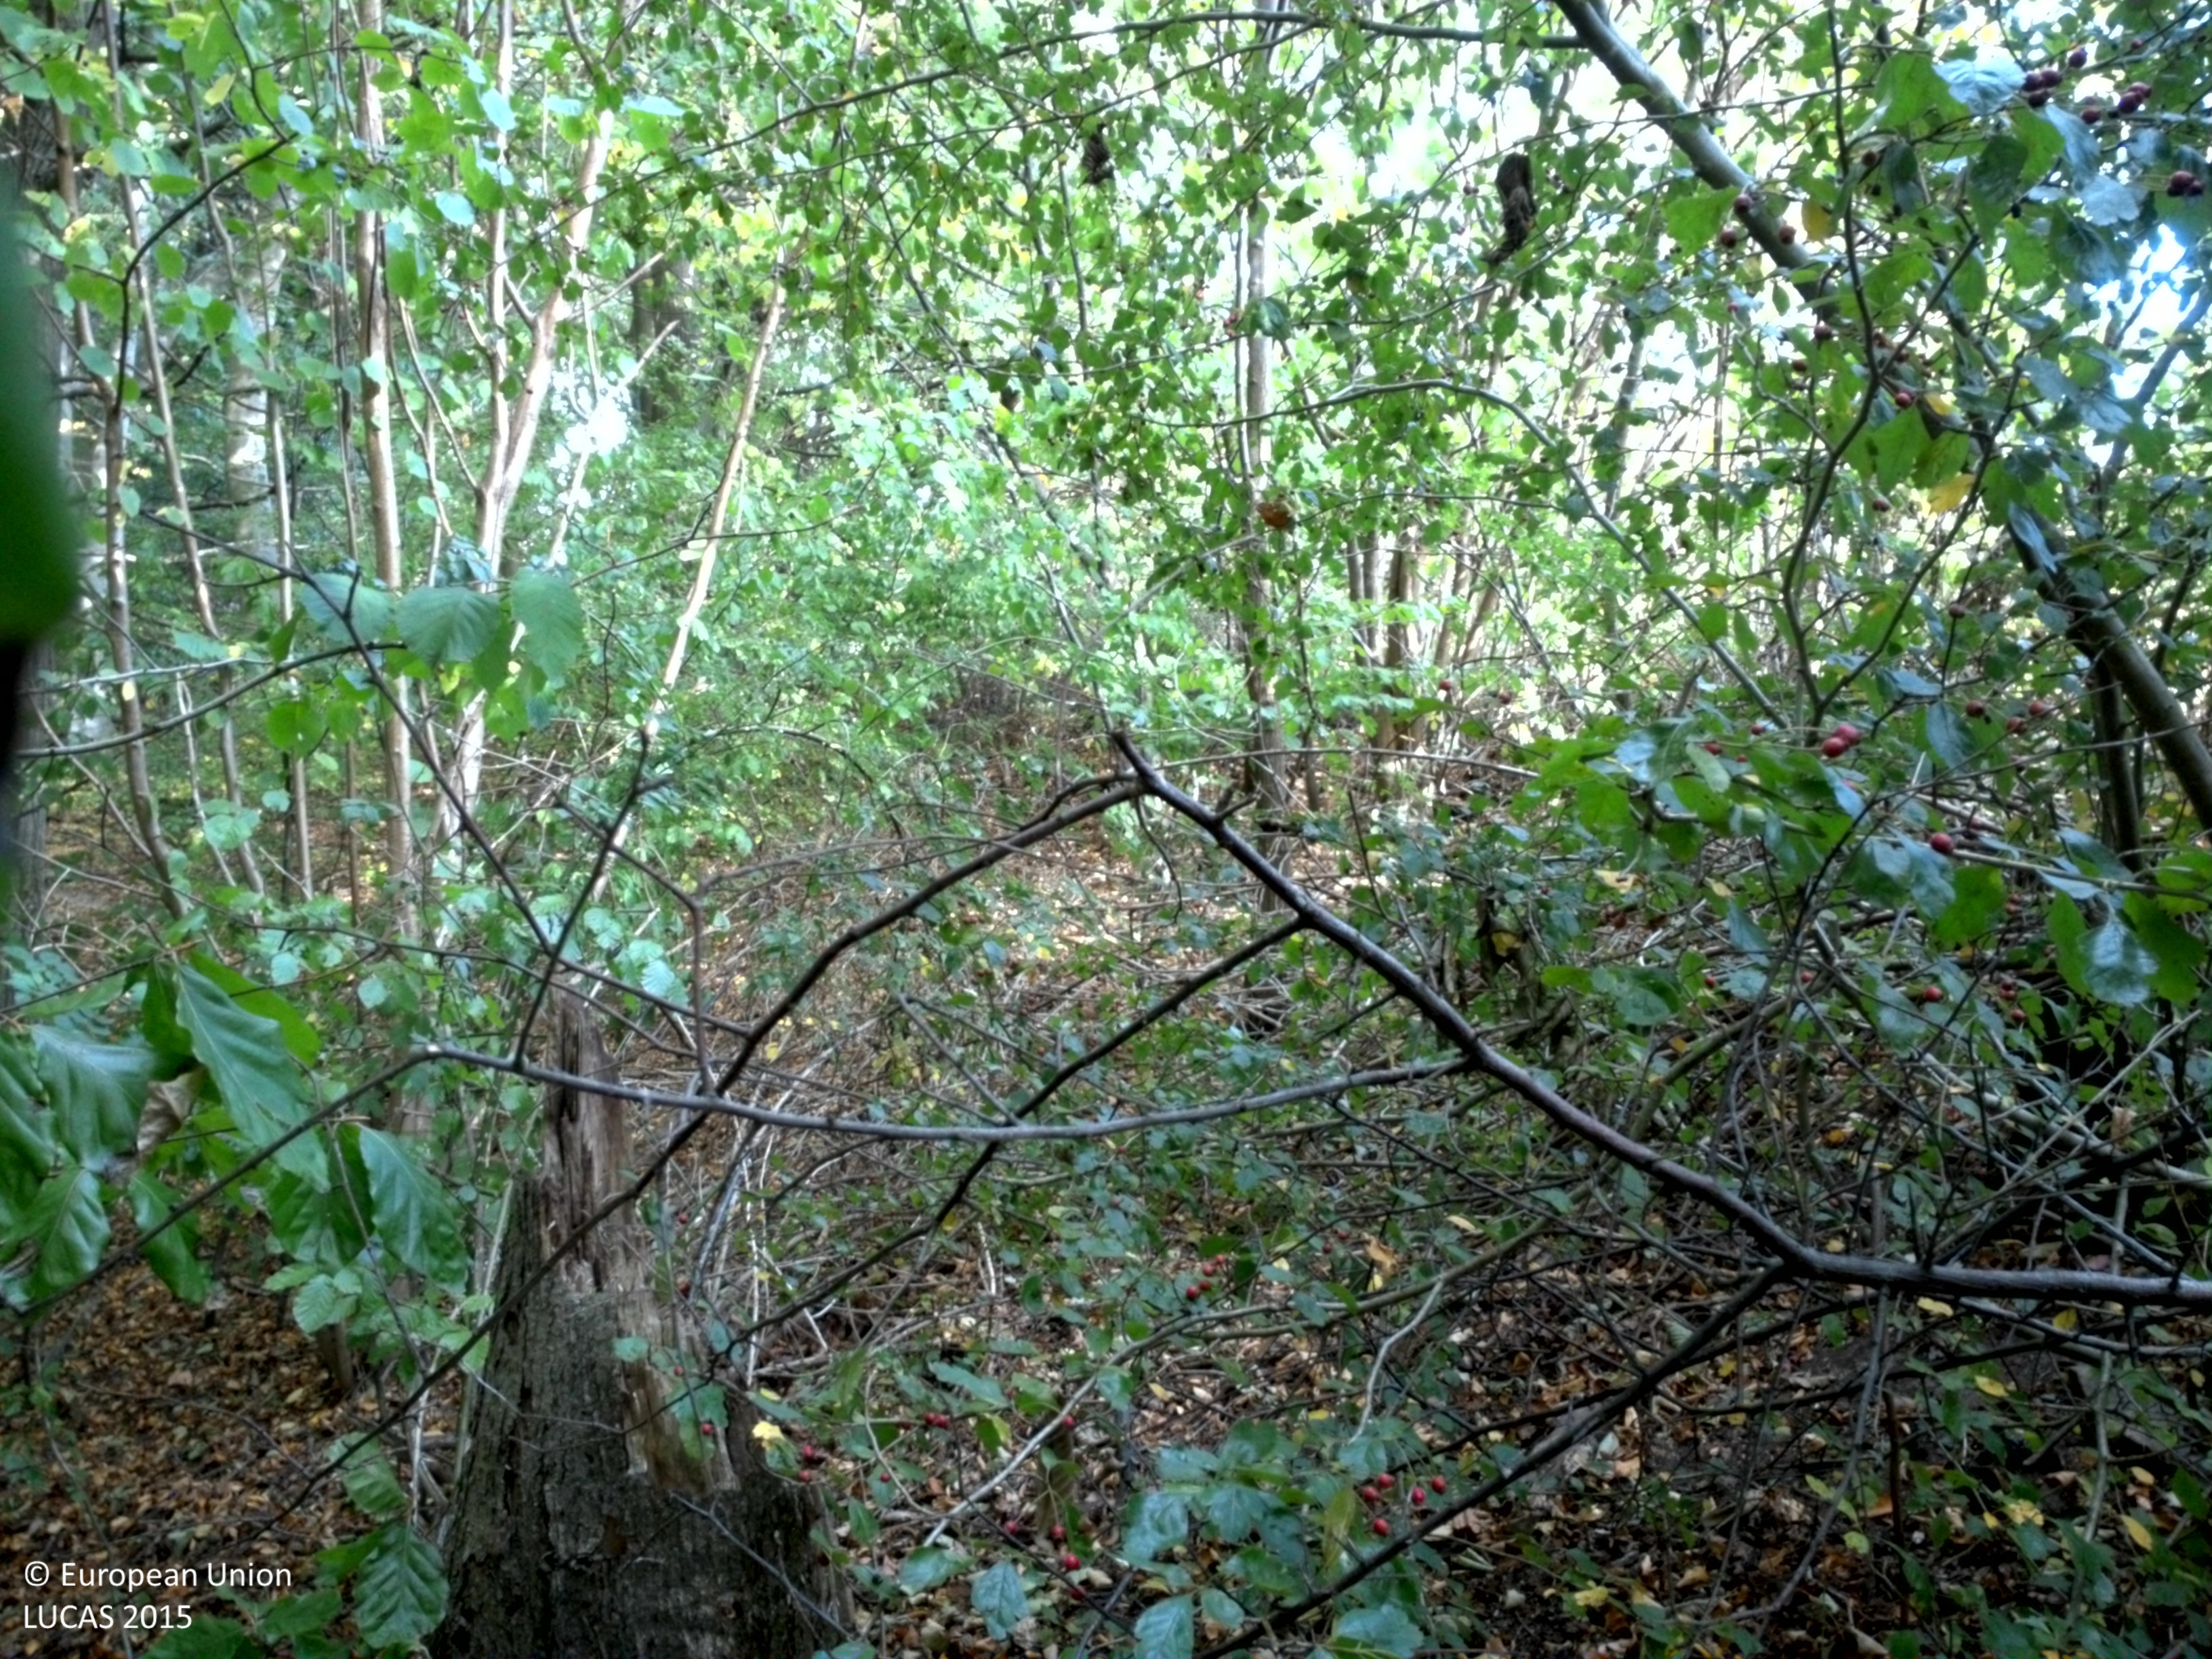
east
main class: Woodland
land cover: Broadleaved woodland
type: beech forest
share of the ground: > 75 %
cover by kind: broadleaved forest trees 85 %, unconsolidated bare surface 10 %, shrubs 5 %
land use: Forestry
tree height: > 5 m
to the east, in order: Broadleaved woodland; Apple fruit; Managed hedges; Apple fruit; Managed hedges; Apple fruit
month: October
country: SE
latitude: 55.6307
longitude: 14.2712
